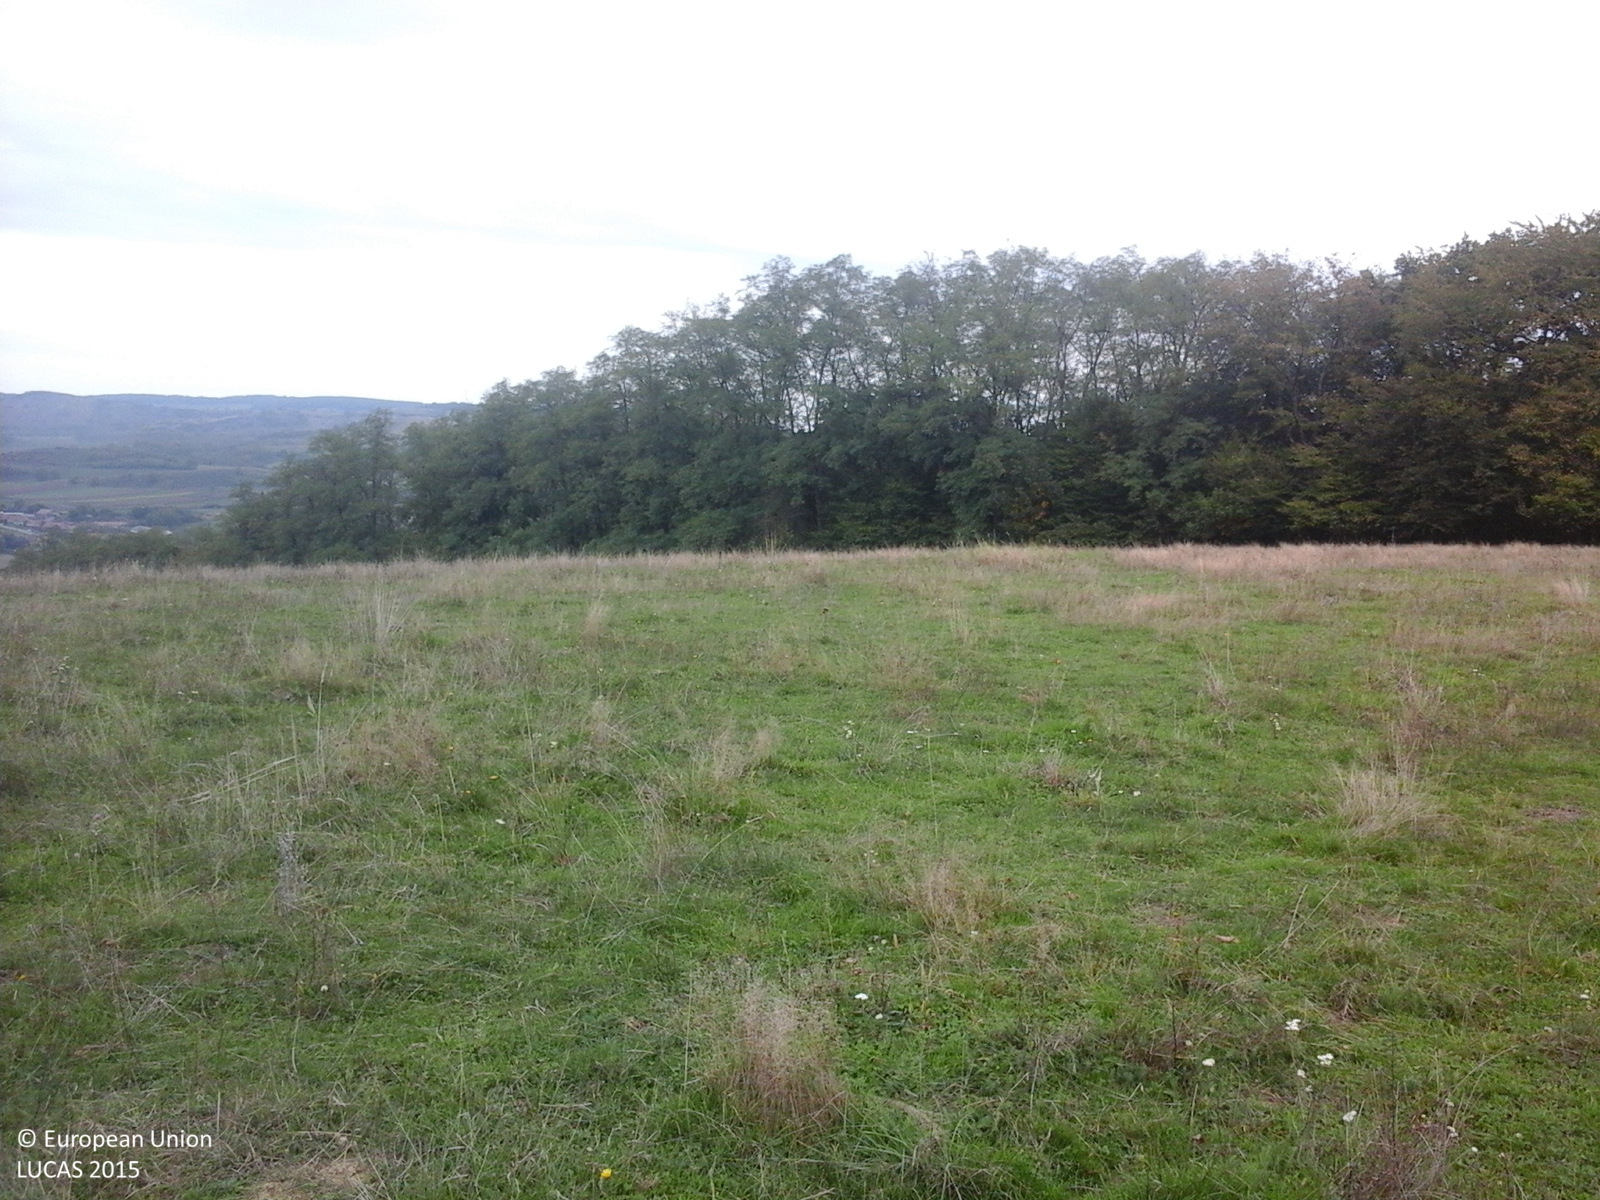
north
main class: Grassland
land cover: Grassland without tree/shrub cover
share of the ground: > 75 %
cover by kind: herbaceous plants 100 %
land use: Agriculture (excluding fallow land and kitchen gardens)
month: October
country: RO
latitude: 46.5280
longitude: 24.7589
